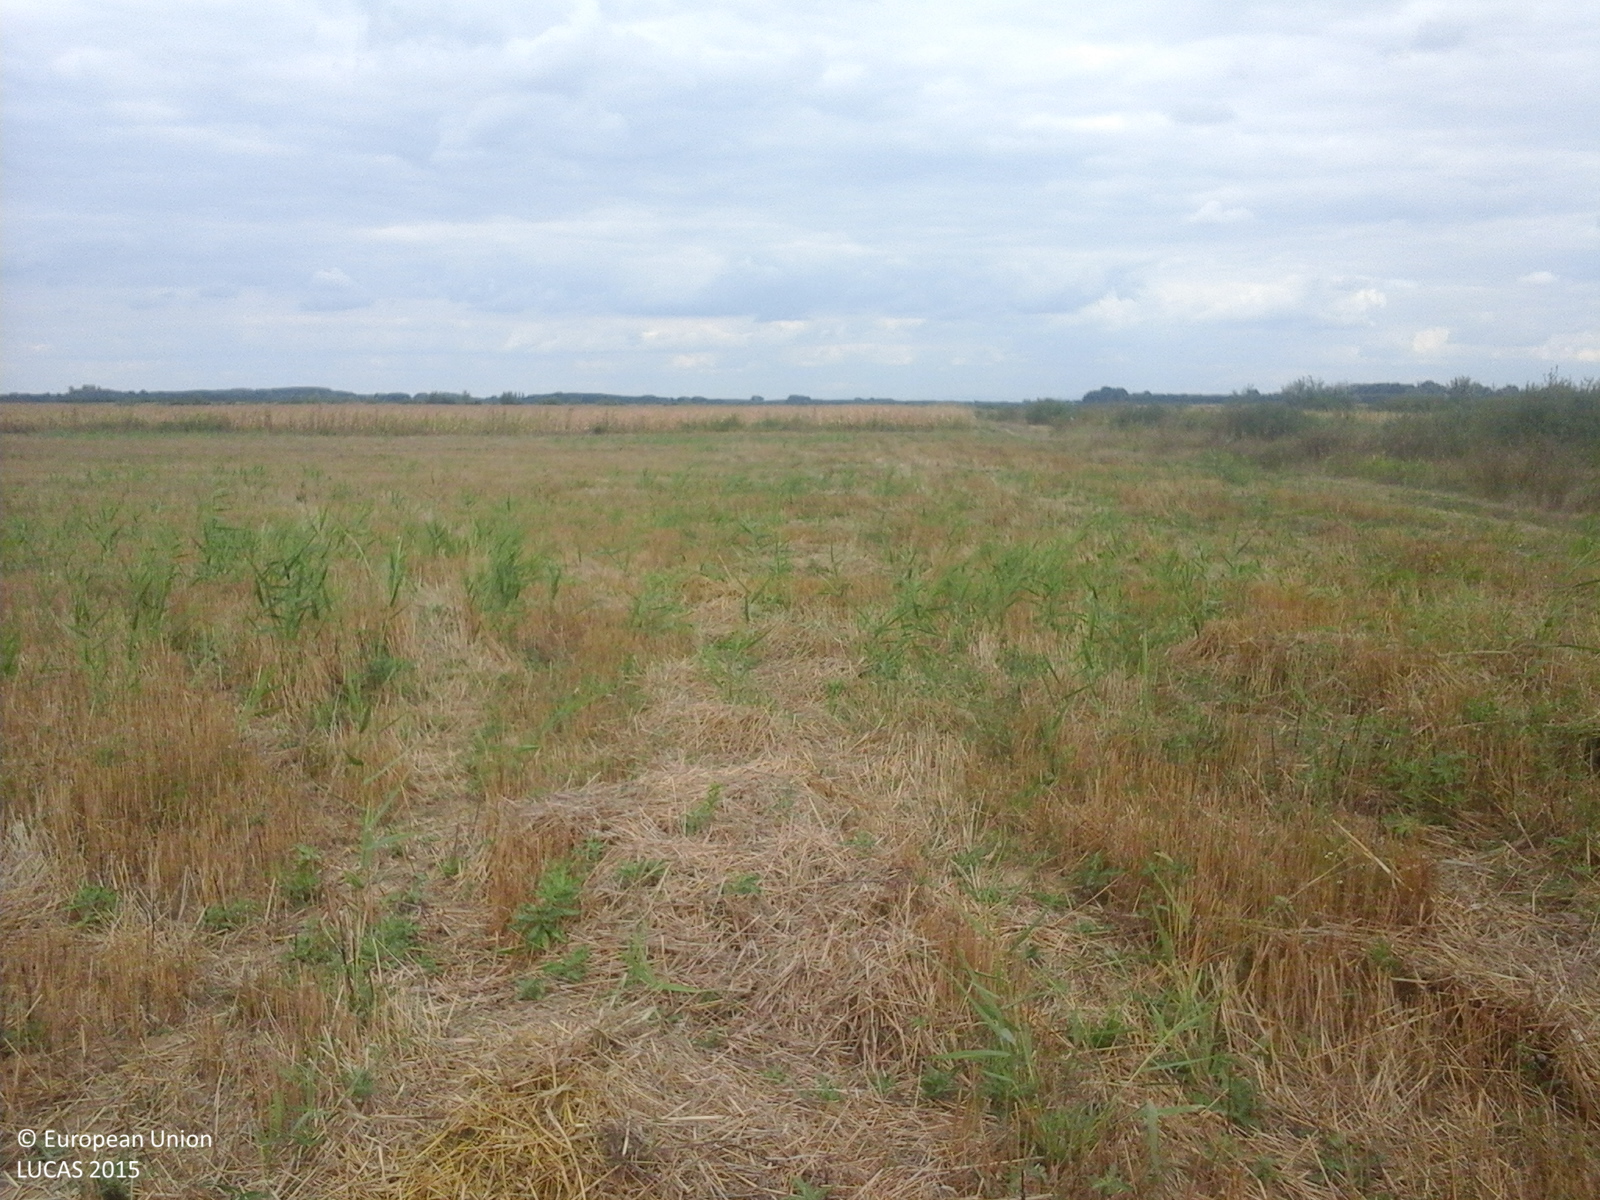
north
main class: Cropland
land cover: Common wheat
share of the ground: > 75 %
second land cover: Spontaneously vegetated surfaces
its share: 25 - 50 %
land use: Agriculture (excluding fallow land and kitchen gardens)
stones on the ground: < 10 %
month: September
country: RO
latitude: 47.8769
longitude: 22.7792
